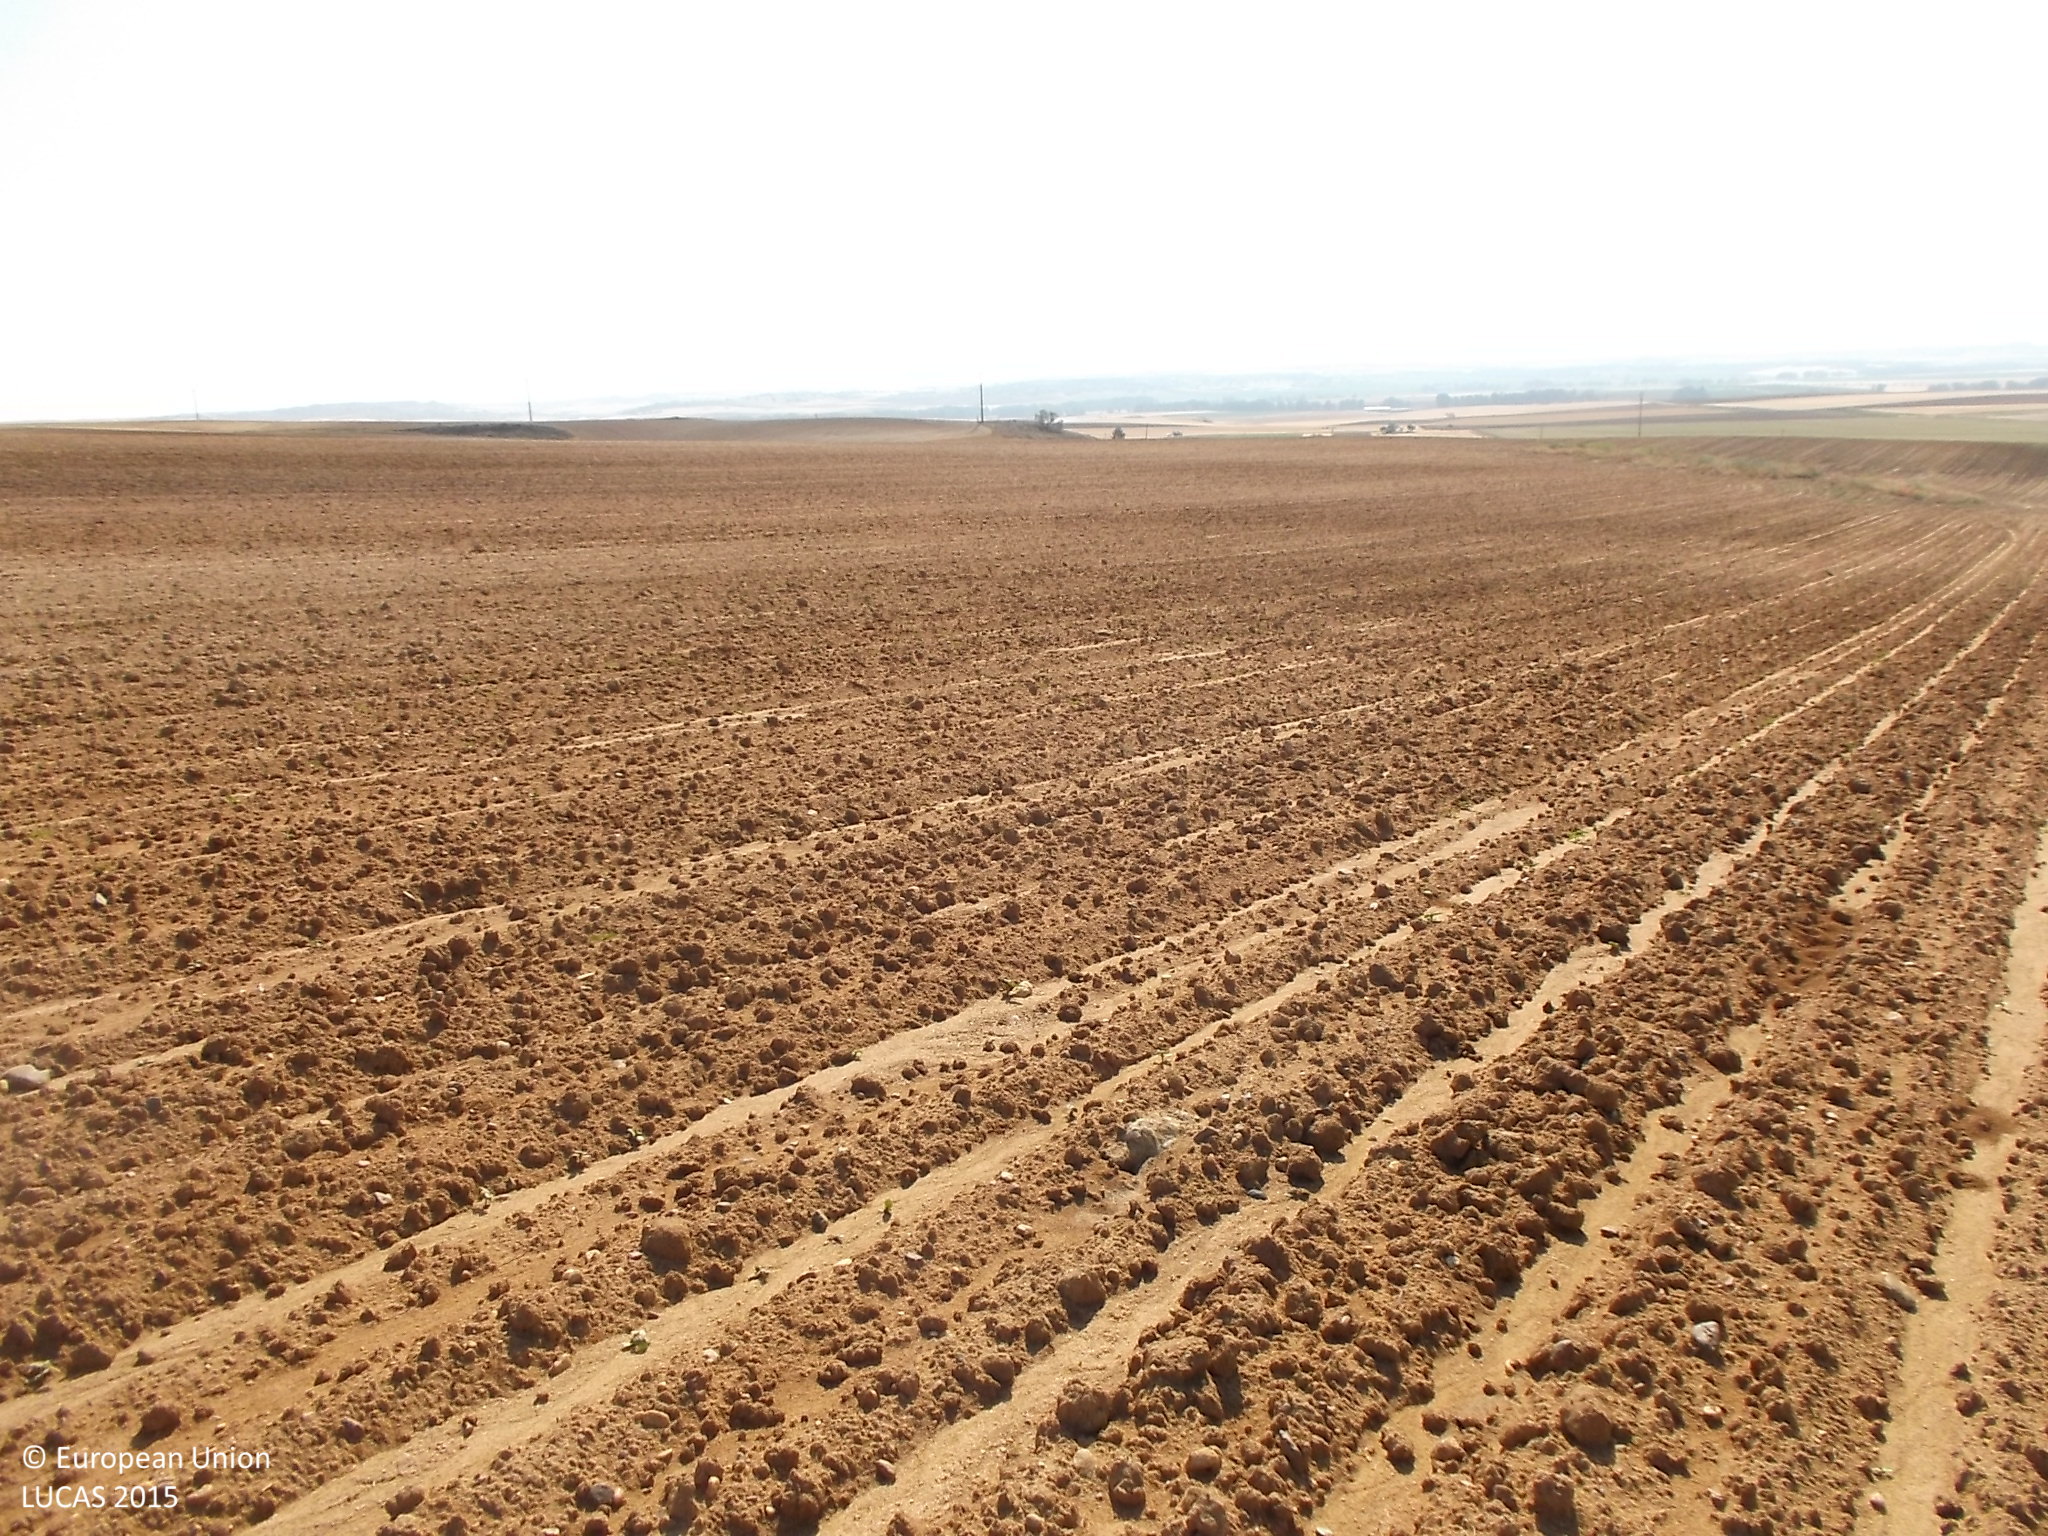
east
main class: Cropland
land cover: Sunflower
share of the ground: < 10 %
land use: Agriculture (excluding fallow land and kitchen gardens)
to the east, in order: Sunflower
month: June
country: ES
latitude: 41.3168
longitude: -5.4280
